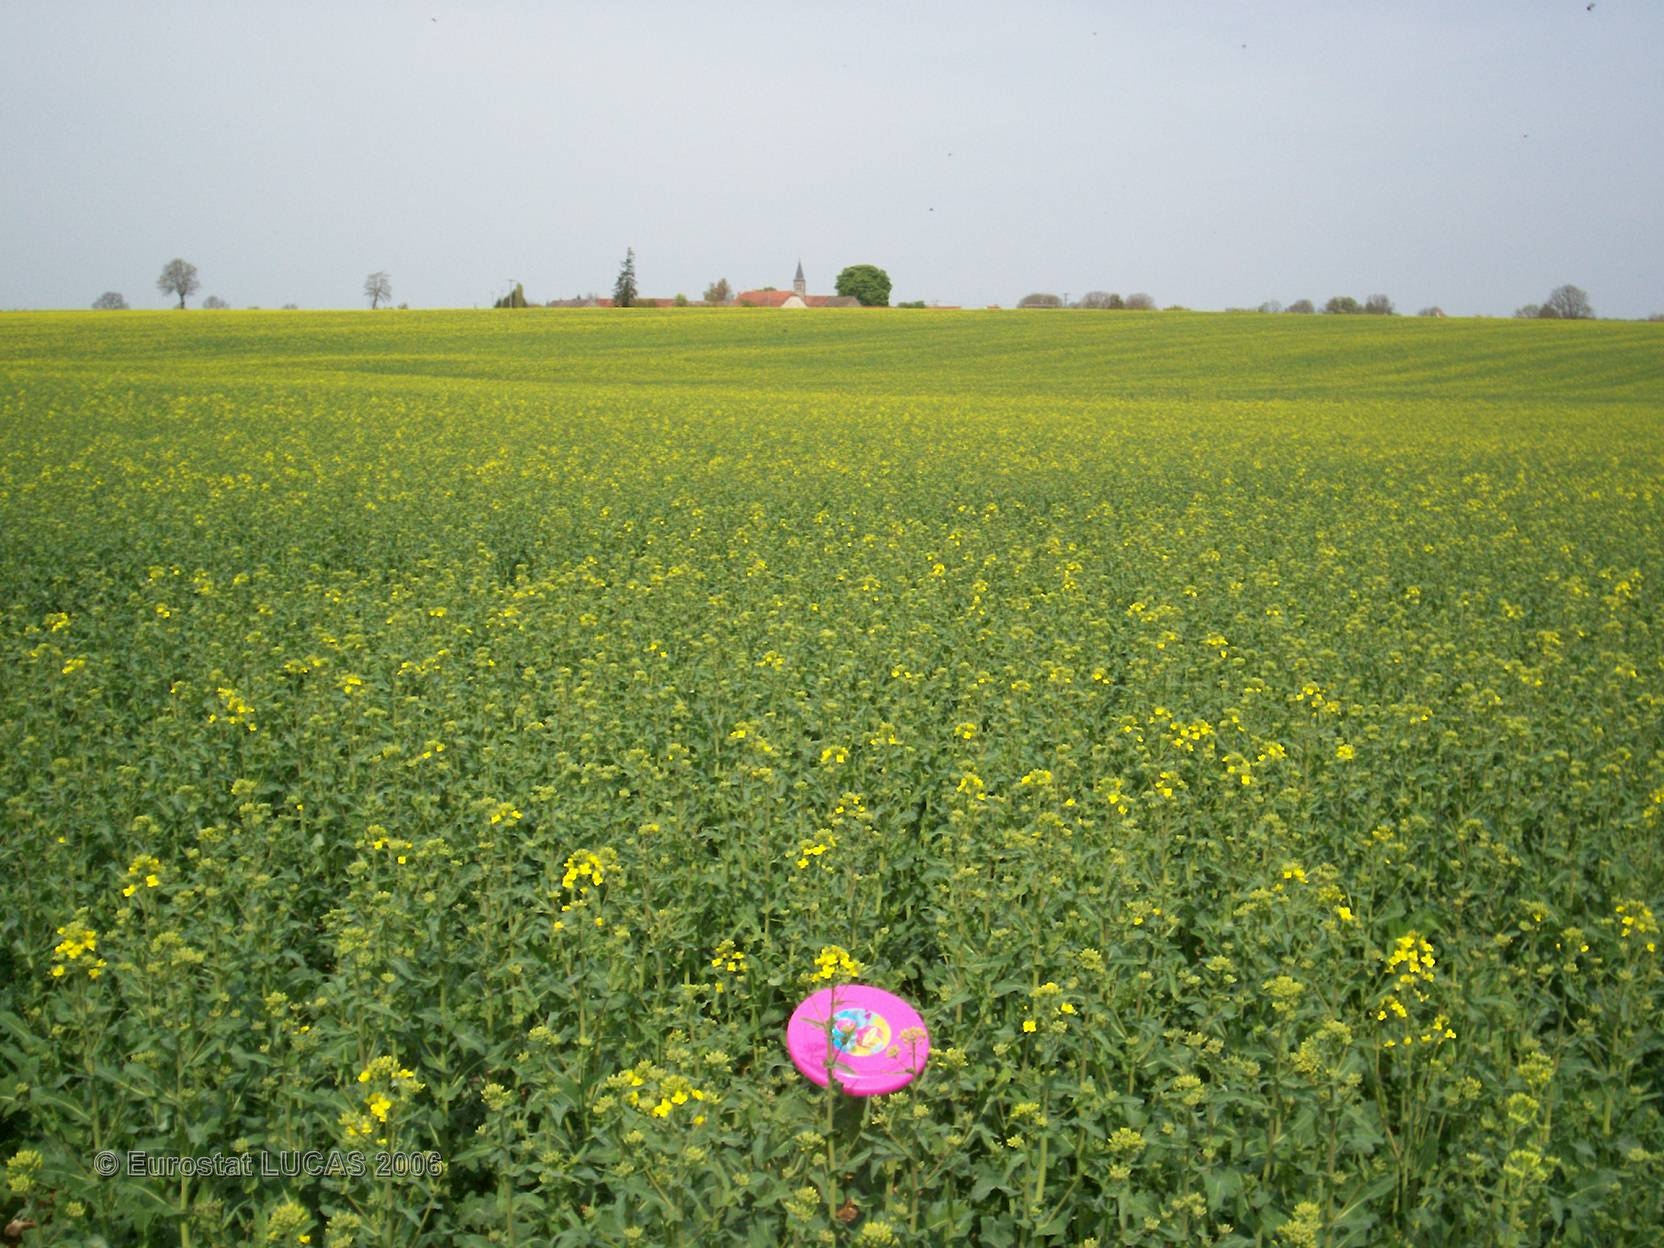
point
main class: Cropland
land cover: Rape and turnip rape
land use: Agriculture (excluding fallow land and kitchen gardens)
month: May
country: FR
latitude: 47.6215
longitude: 4.5835
